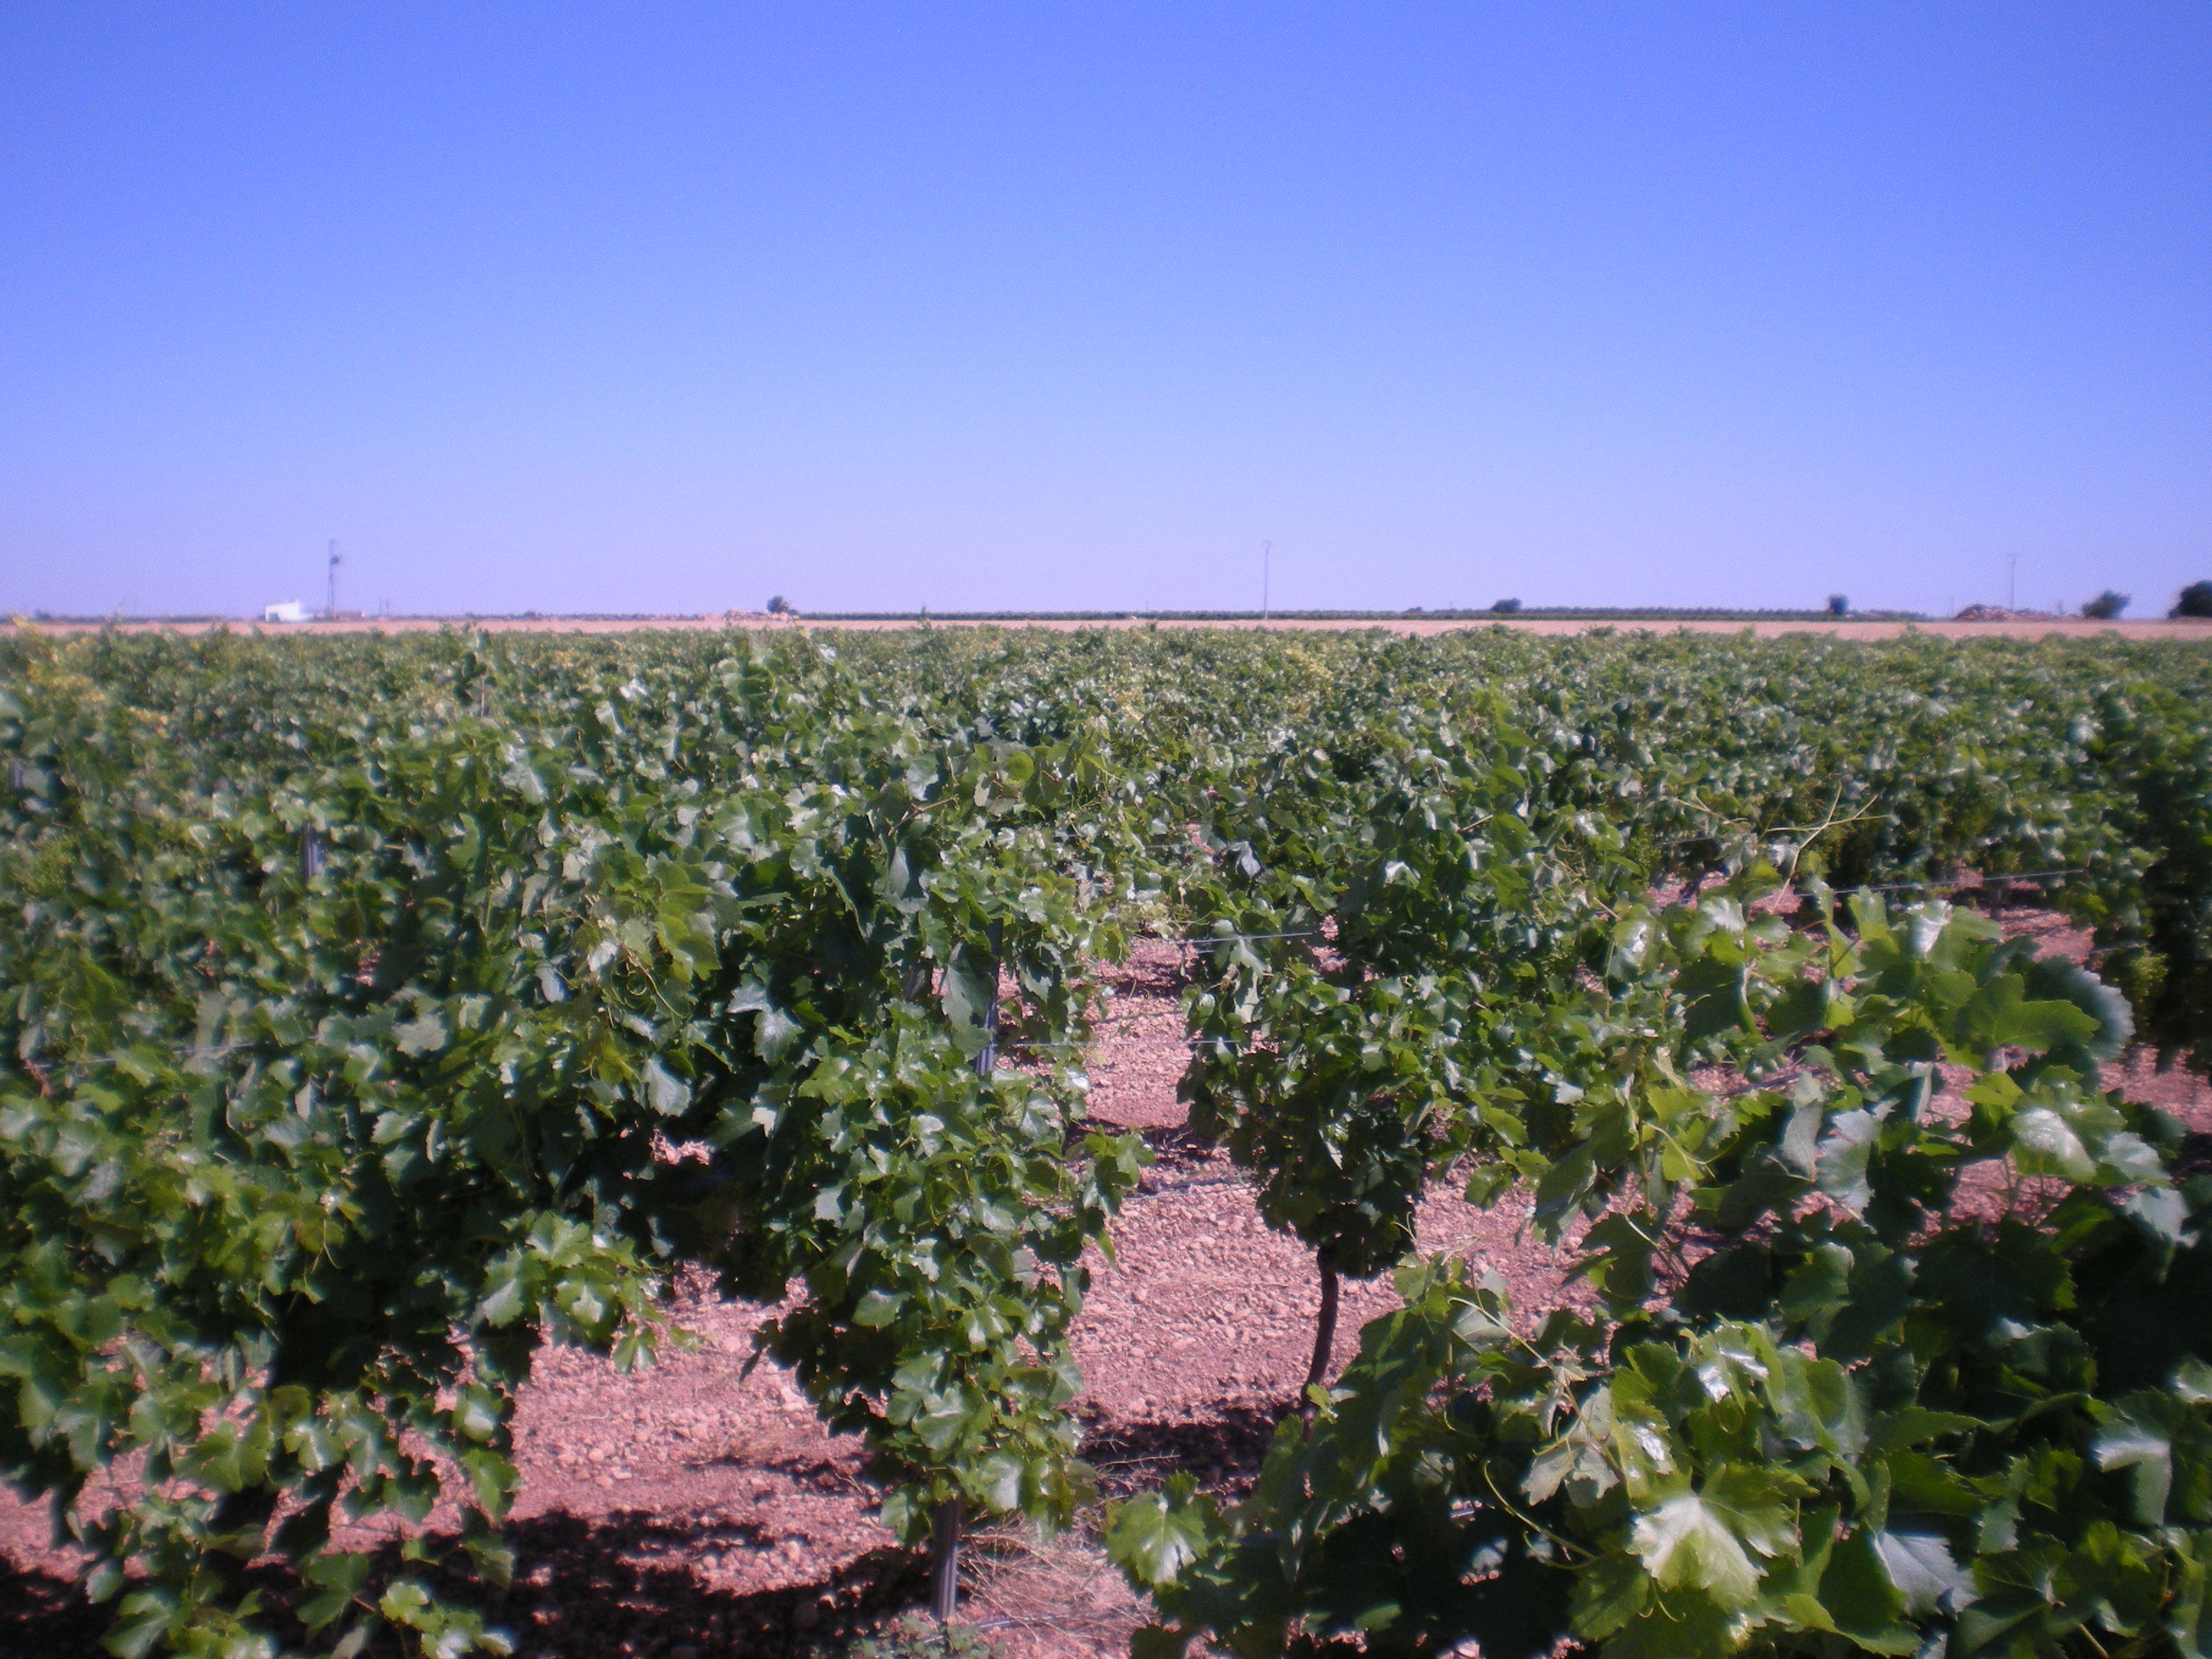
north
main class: Cropland
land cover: Vineyards
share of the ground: 25 - 50 %
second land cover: Other bare soil
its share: > 75 %
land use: Agriculture (excluding fallow land and kitchen gardens)
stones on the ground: 10 - 25 %
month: June
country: ES
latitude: 39.1856
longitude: -3.0841
